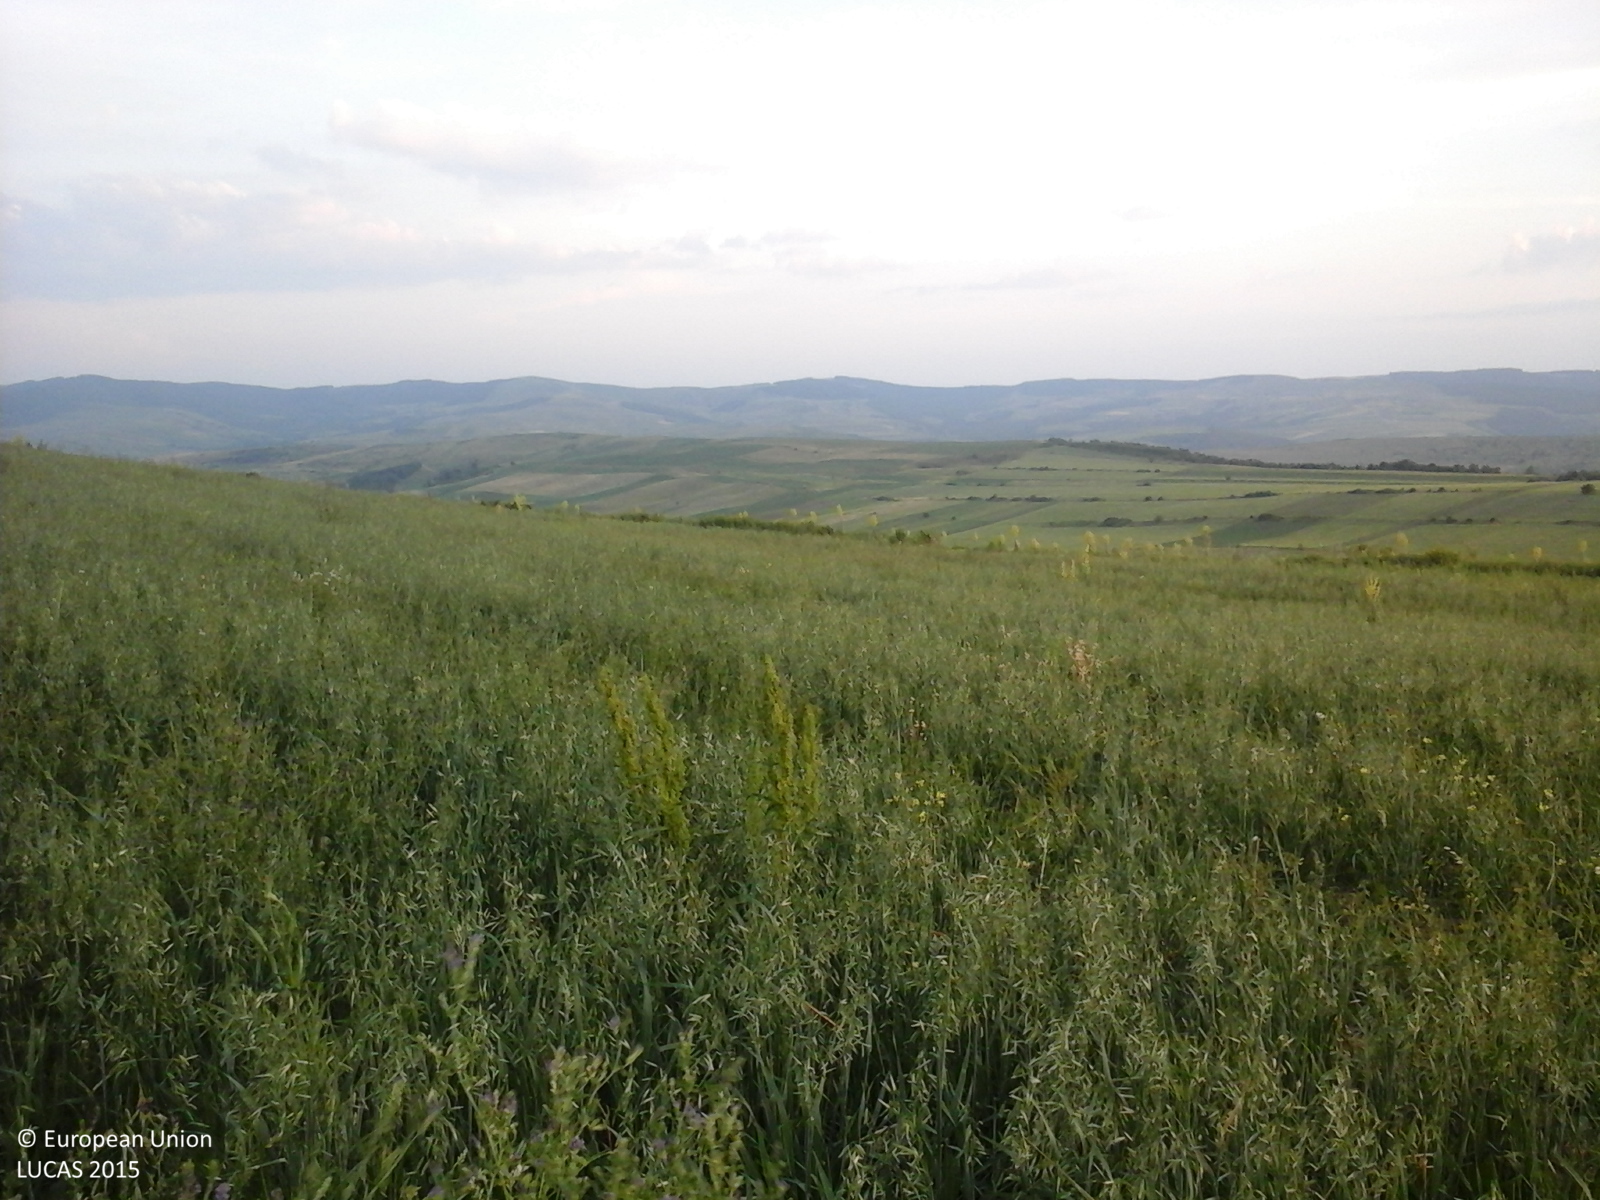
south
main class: Cropland
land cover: Oats
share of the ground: > 75 %
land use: Agriculture (excluding fallow land and kitchen gardens)
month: June
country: RO
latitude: 46.6822
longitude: 27.4870
